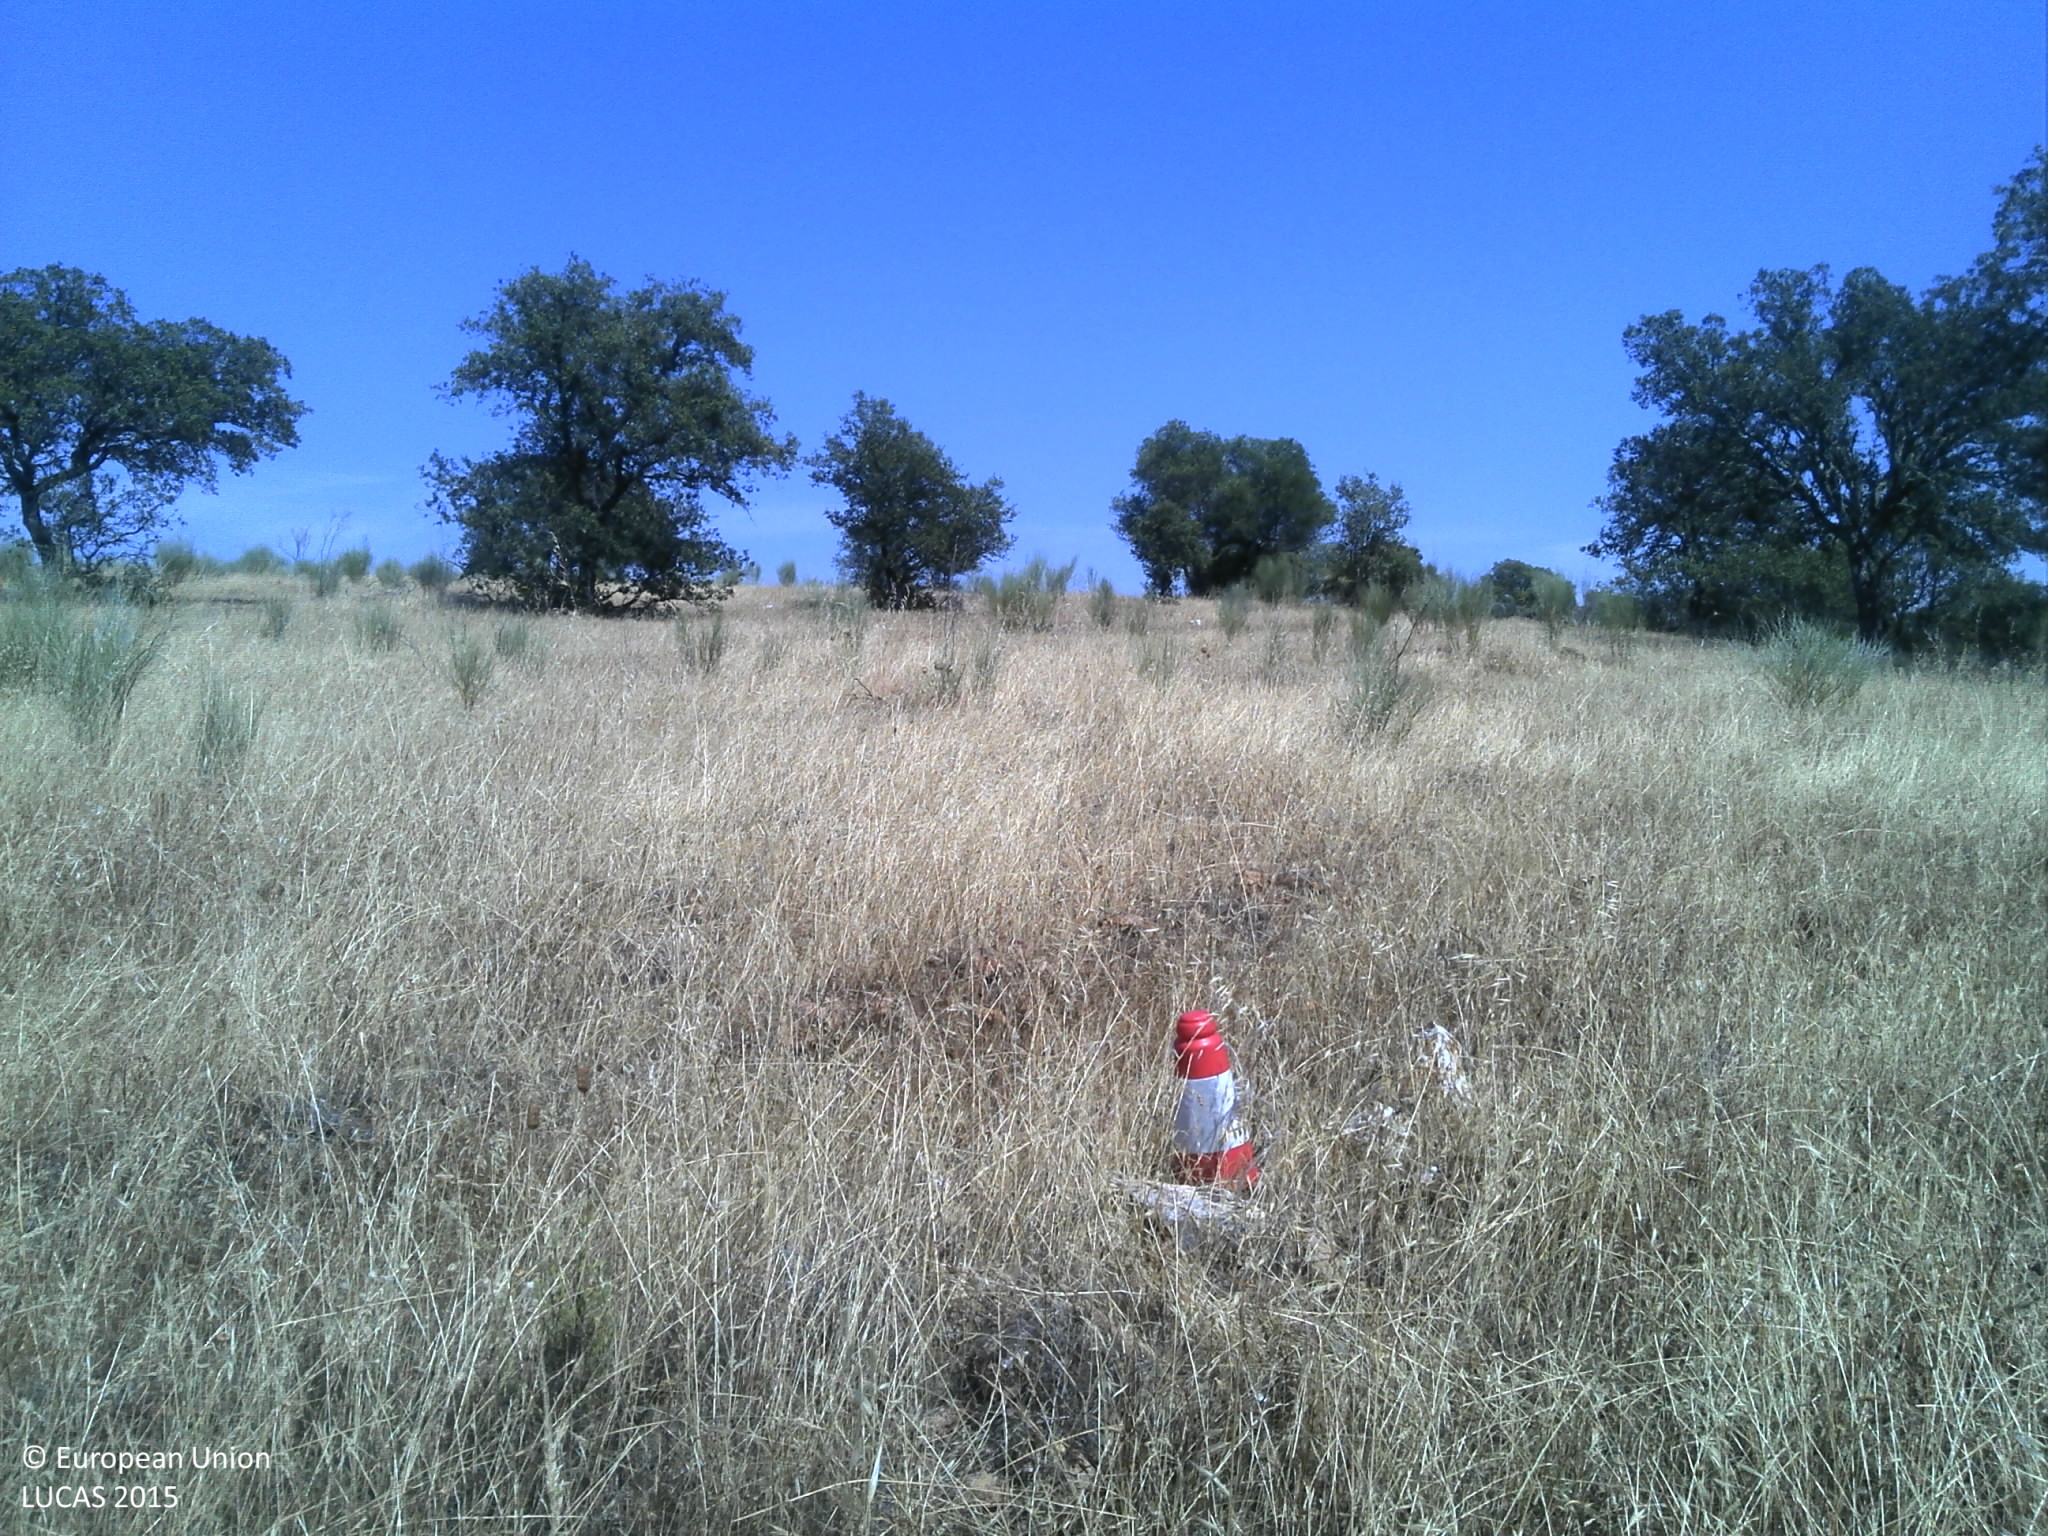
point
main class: Woodland
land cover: Broadleaved woodland
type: broadleaved evergreen forest
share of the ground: 25 - 50 %
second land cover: Grassland without tree/shrub cover
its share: 25 - 50 %
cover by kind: broadleaved forest trees 35 %, herbaceous plants 35 %, unconsolidated bare surface 20 %, shrubs 5 %
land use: Forestry
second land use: Agriculture (excluding fallow land and kitchen gardens)
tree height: > 5 m
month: June
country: PT
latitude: 39.7954
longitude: -7.1527
